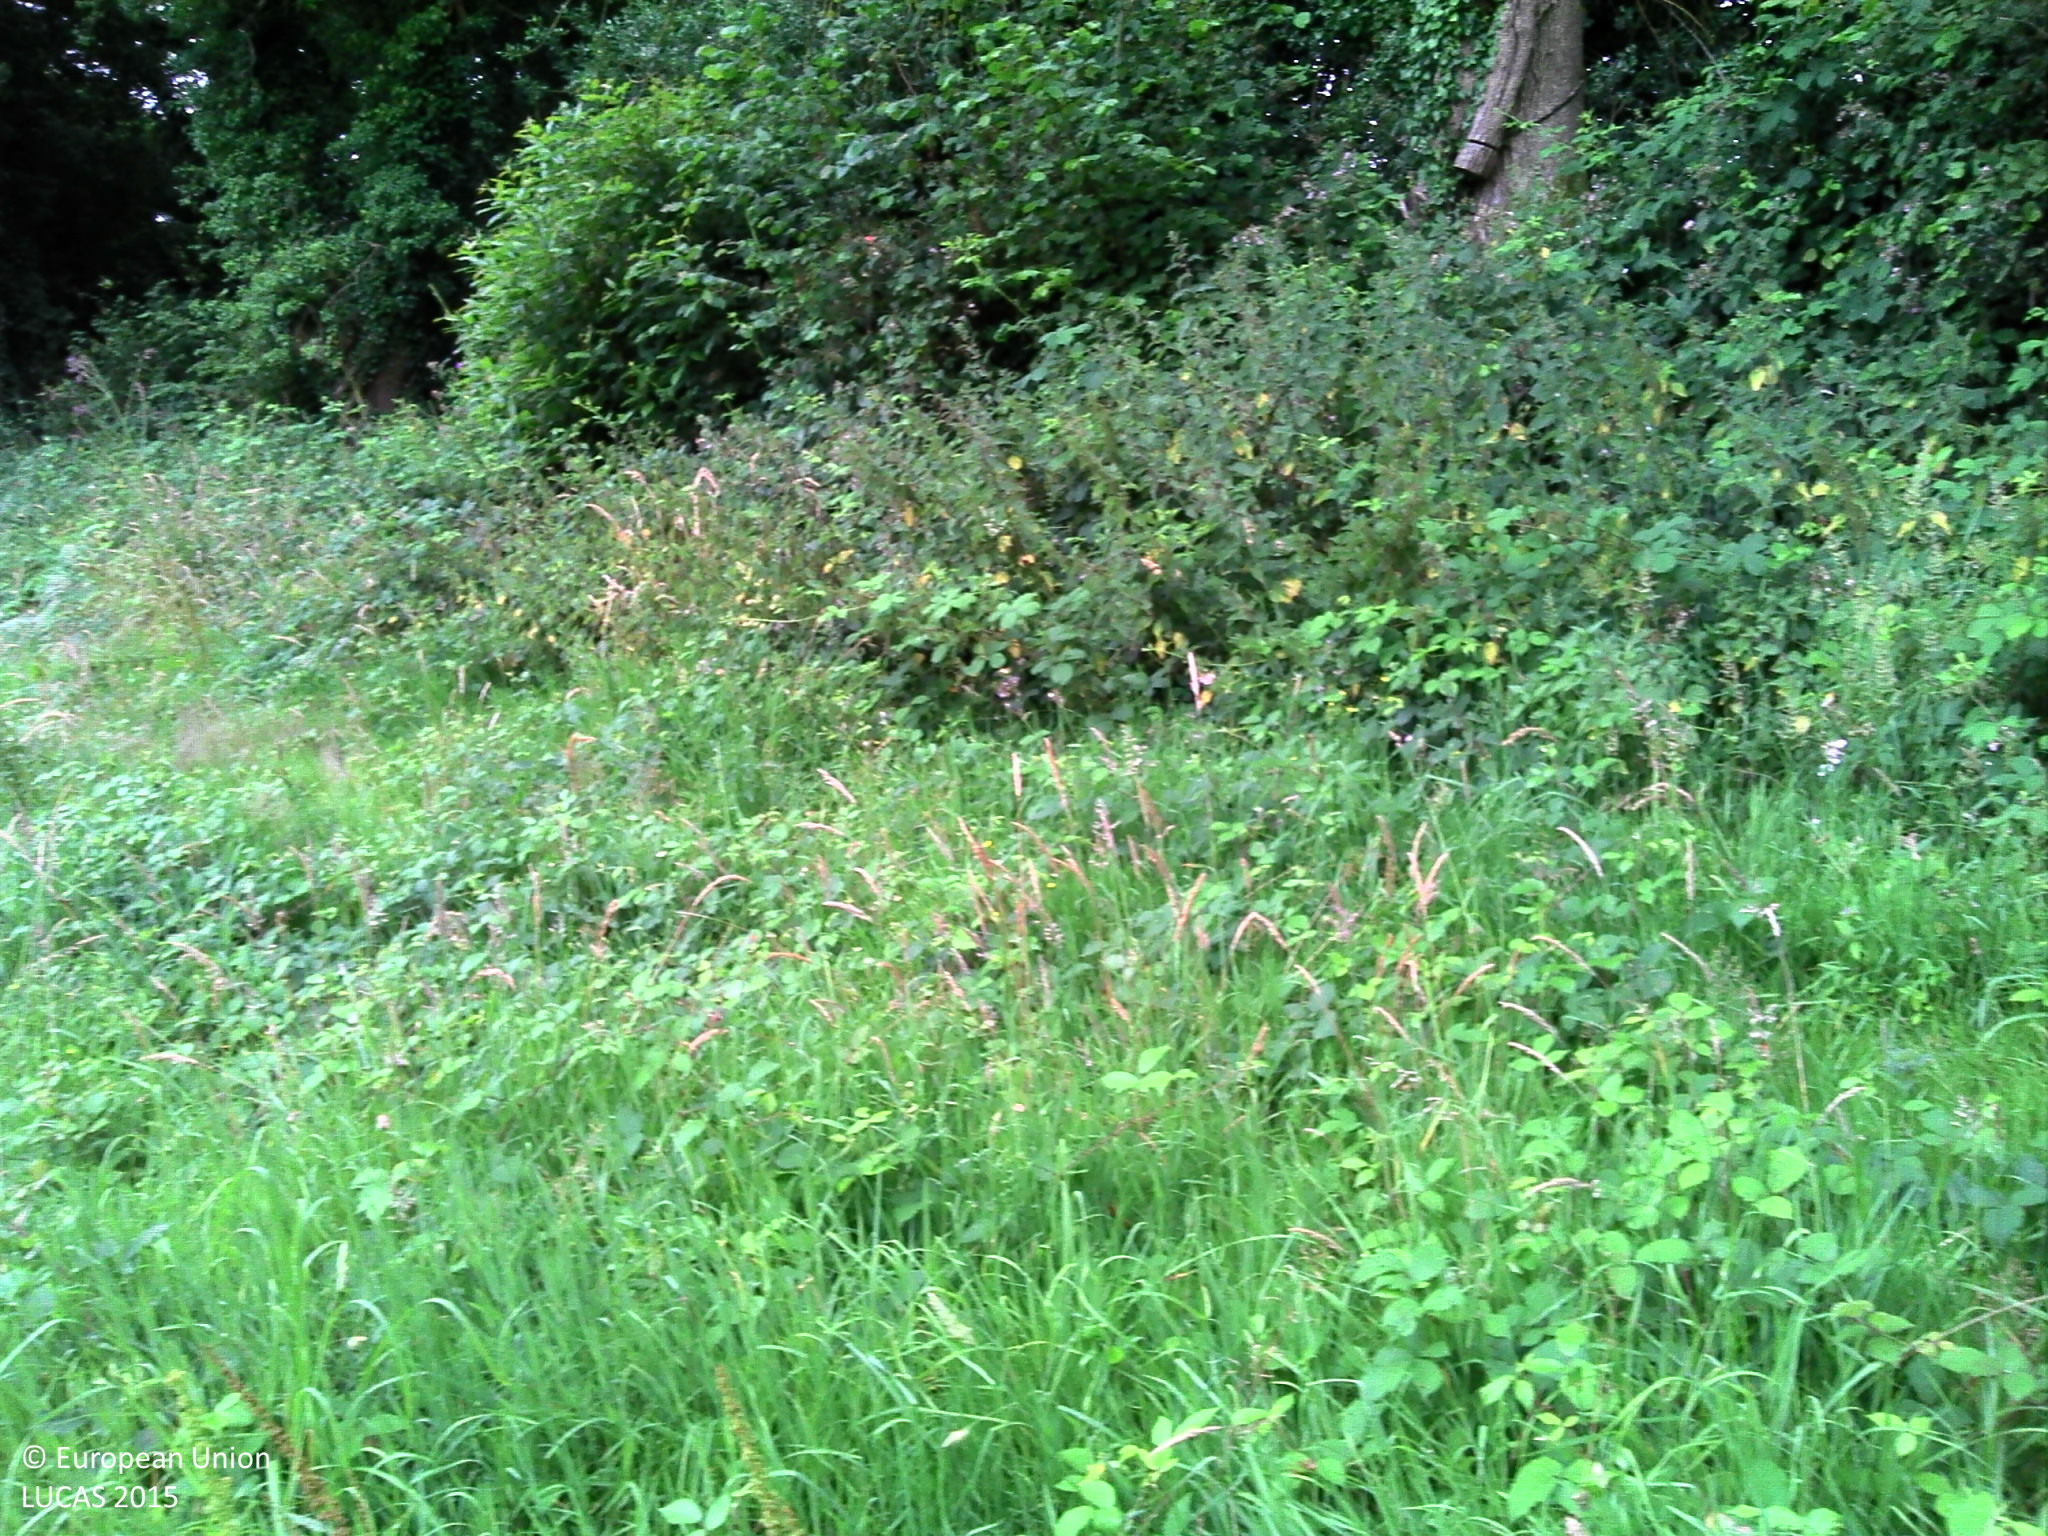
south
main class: Grassland
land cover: Grassland without tree/shrub cover
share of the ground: > 75 %
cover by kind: herbaceous plants 50 %, unconsolidated bare surface 25 %, consolidated bare surface 20 %, shrubs 5 %
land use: Agriculture (excluding fallow land and kitchen gardens)
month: July
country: FR
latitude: 48.1615
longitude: -3.5909
